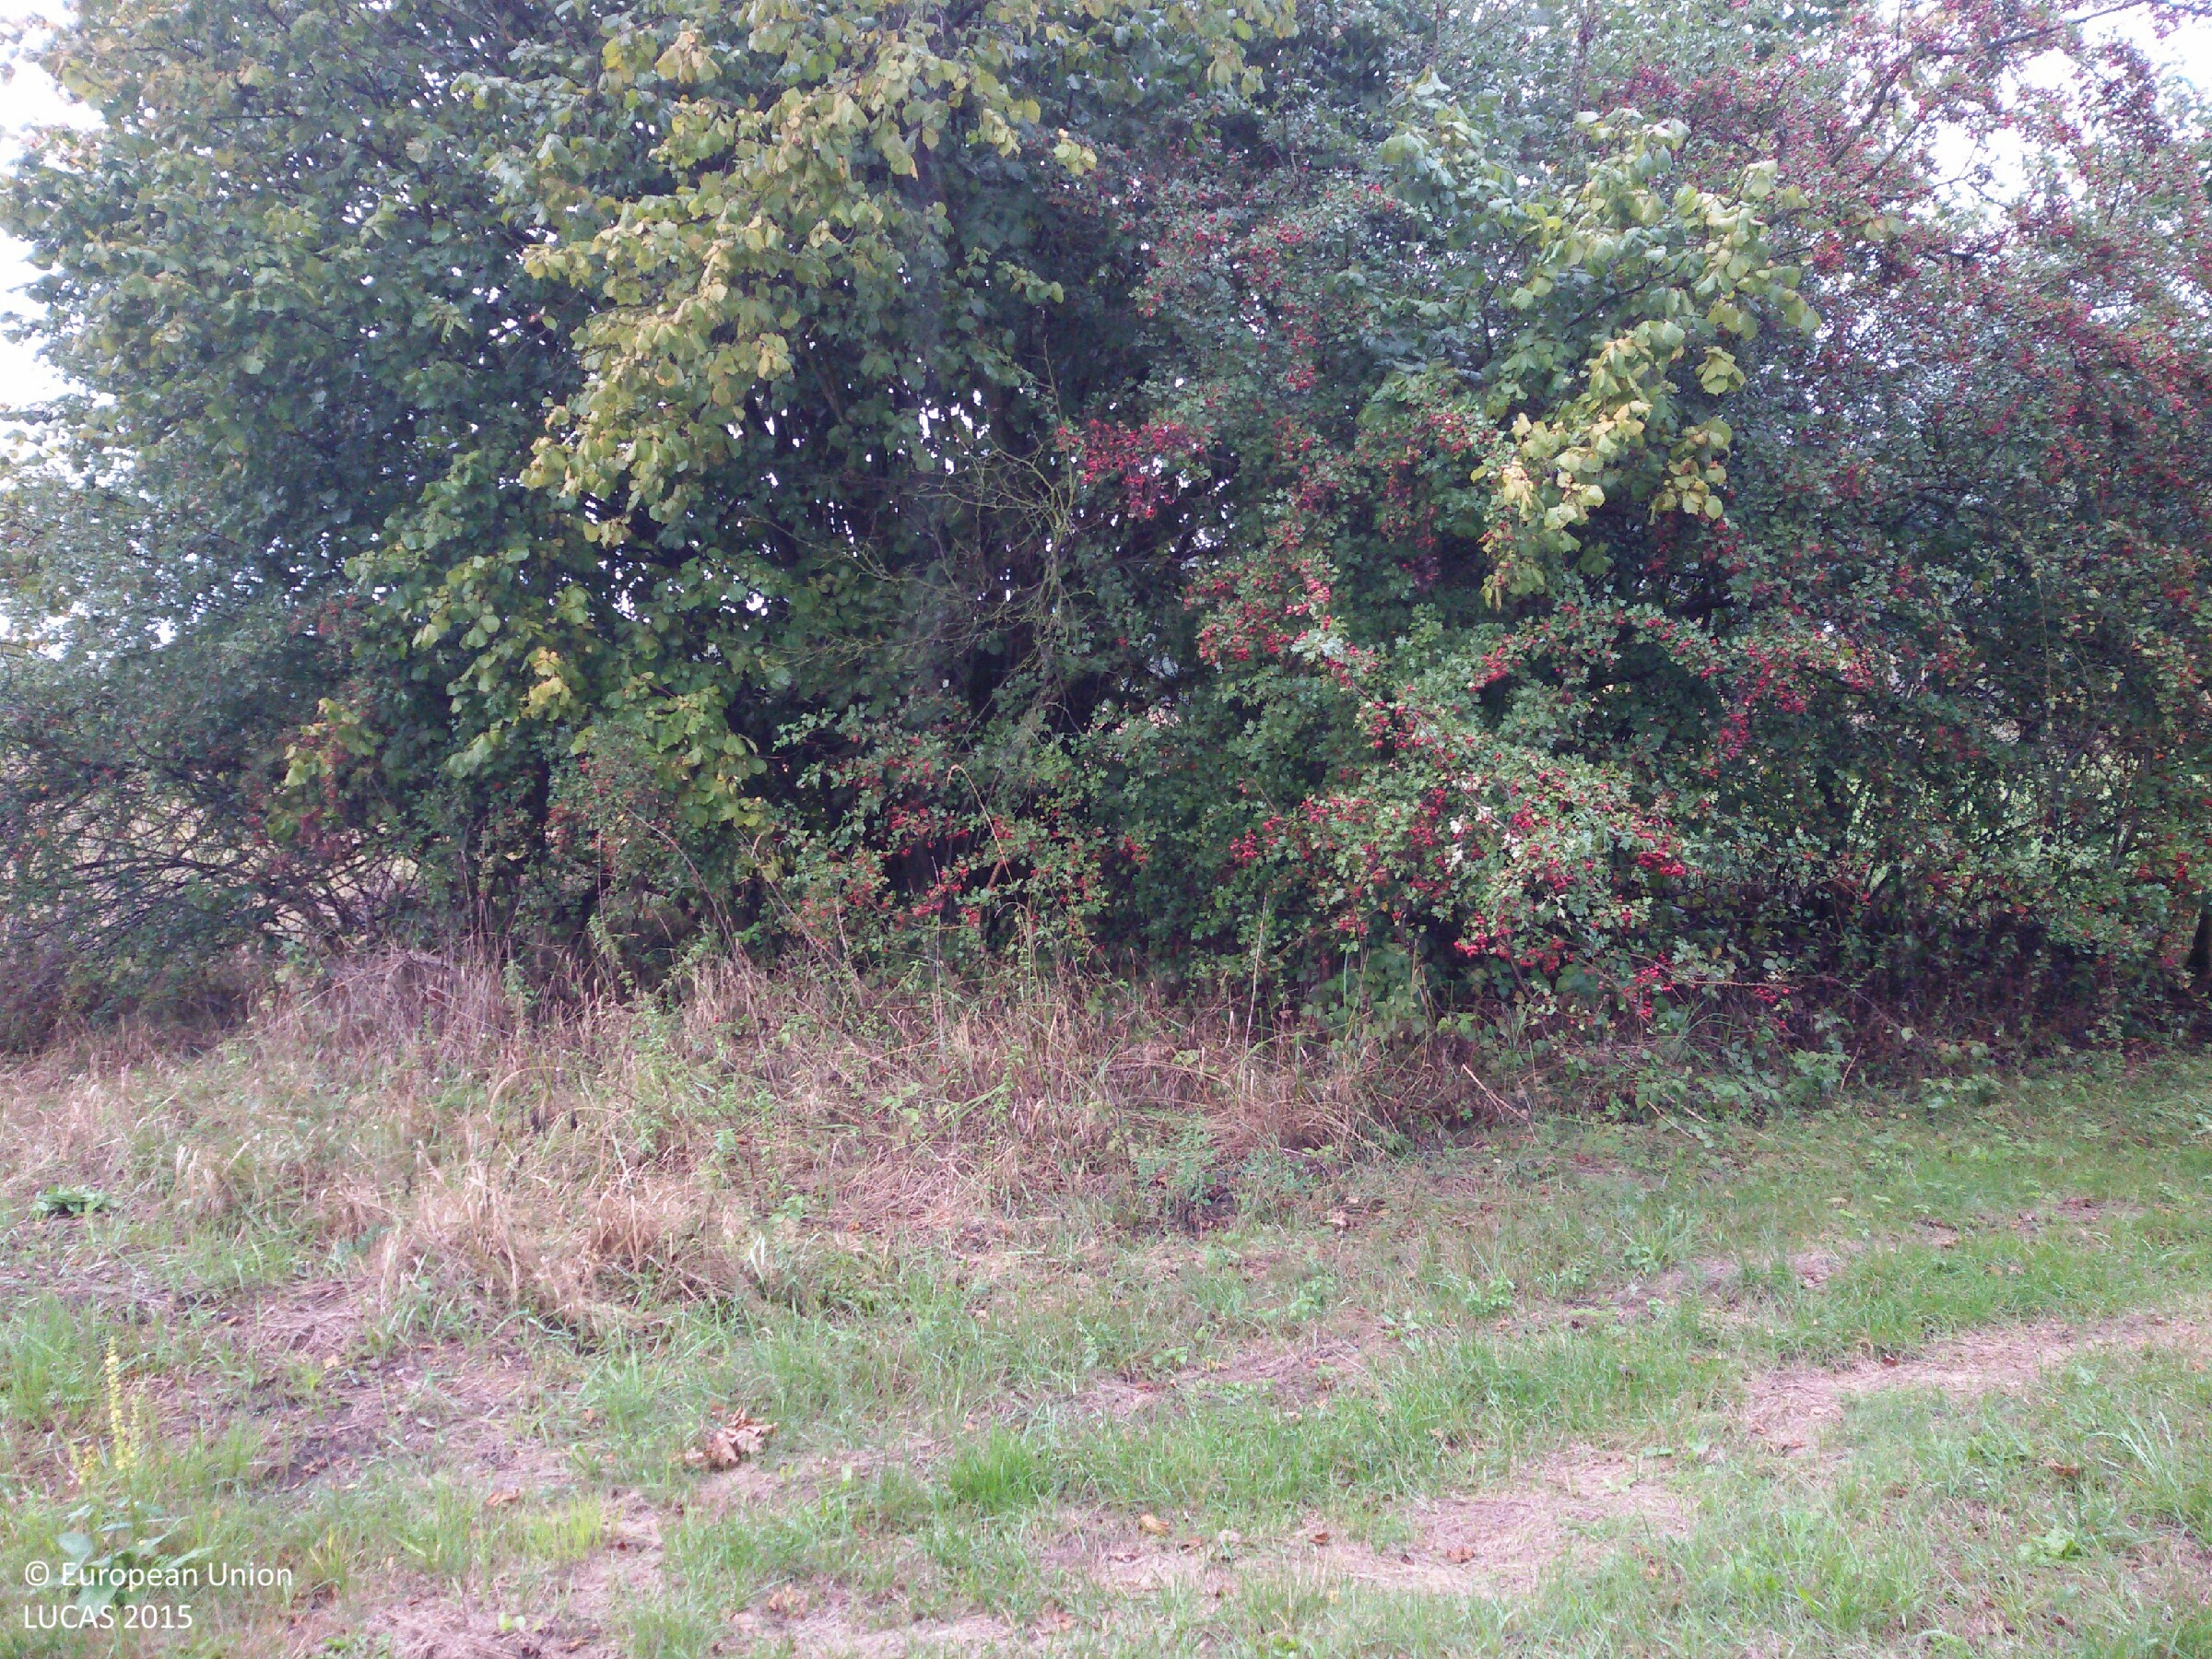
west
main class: Woodland
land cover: Broadleaved woodland
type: mesophytic deciduous forest
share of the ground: 25 - 50 %
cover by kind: herbaceous plants 55 %, broadleaved forest trees 45 %
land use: Semi-natural and natural areas not in use
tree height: > 5 m
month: September
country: PL
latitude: 51.8000
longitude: 14.6569
